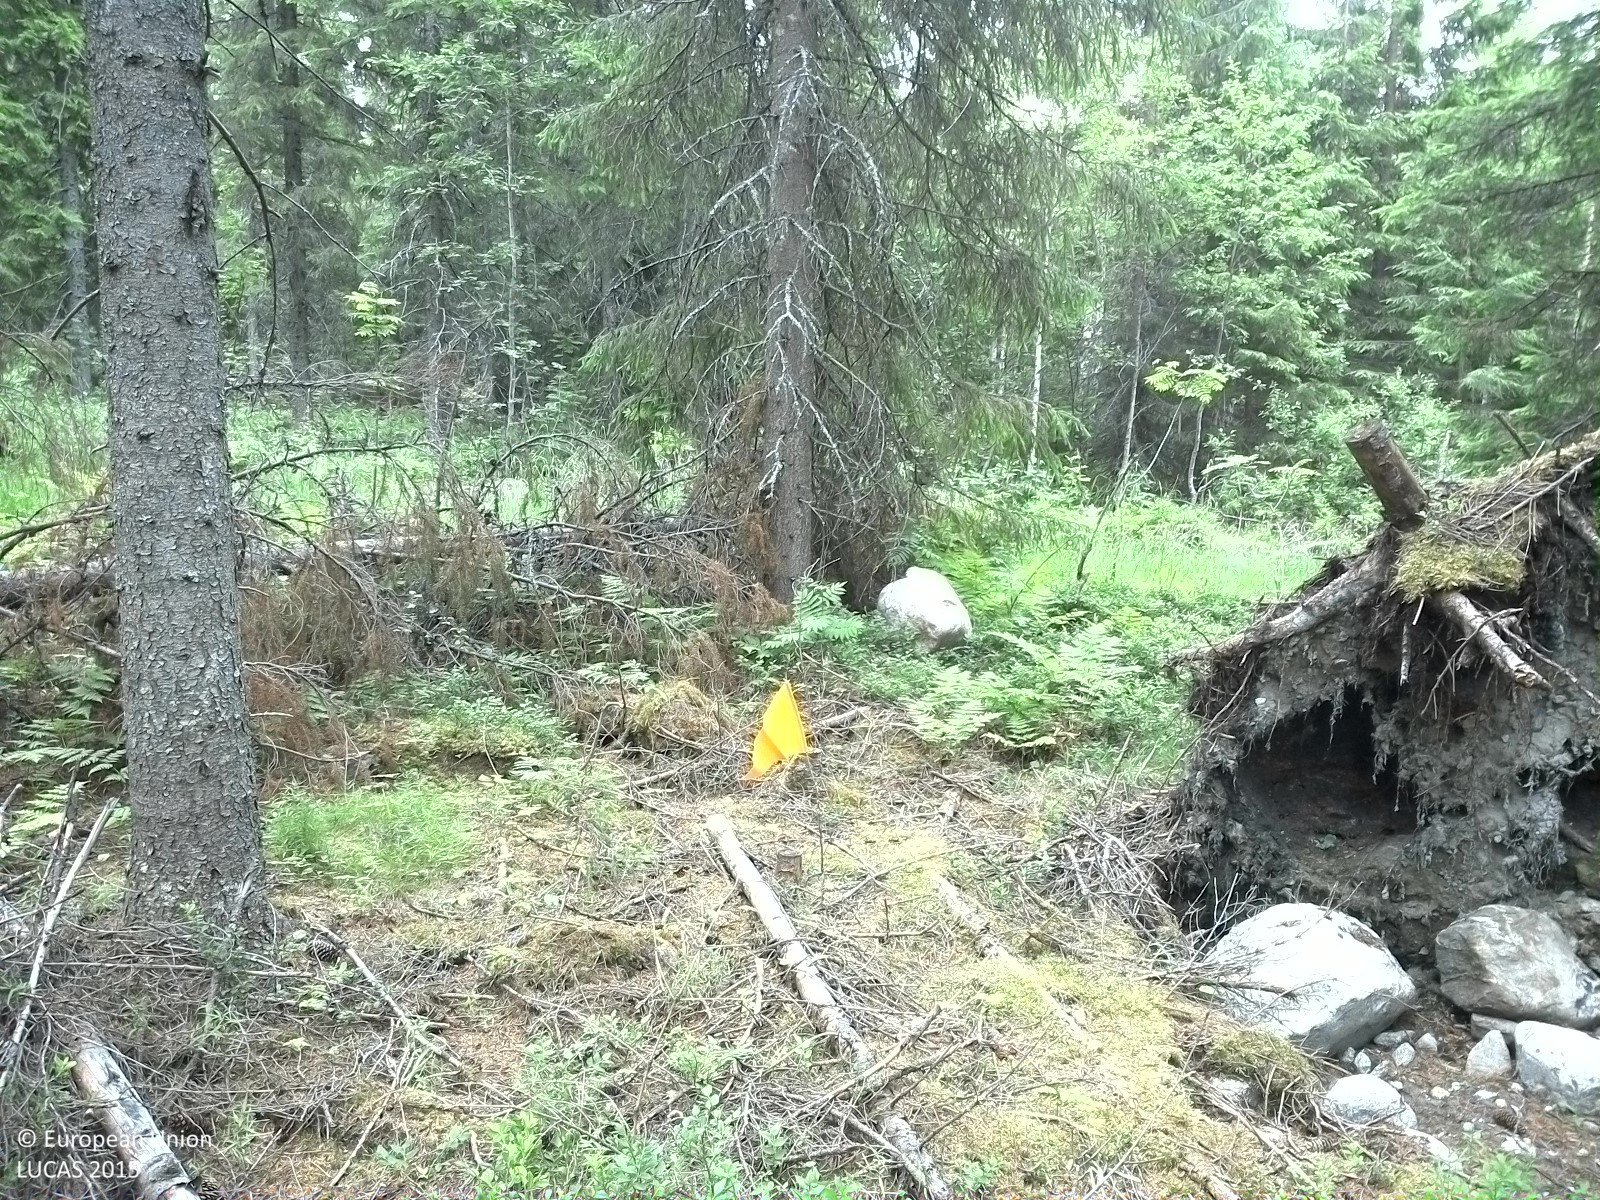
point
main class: Woodland
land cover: Spruce dominated coniferous woodland
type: boreal forest
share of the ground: 25 - 50 %
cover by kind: coniferous forest trees 45 %, shrubs 35 %, herbaceous plants 10 %, lichens and mosses 10 %
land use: Forestry
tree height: > 5 m
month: July
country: SE
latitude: 62.1246
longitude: 16.9793
